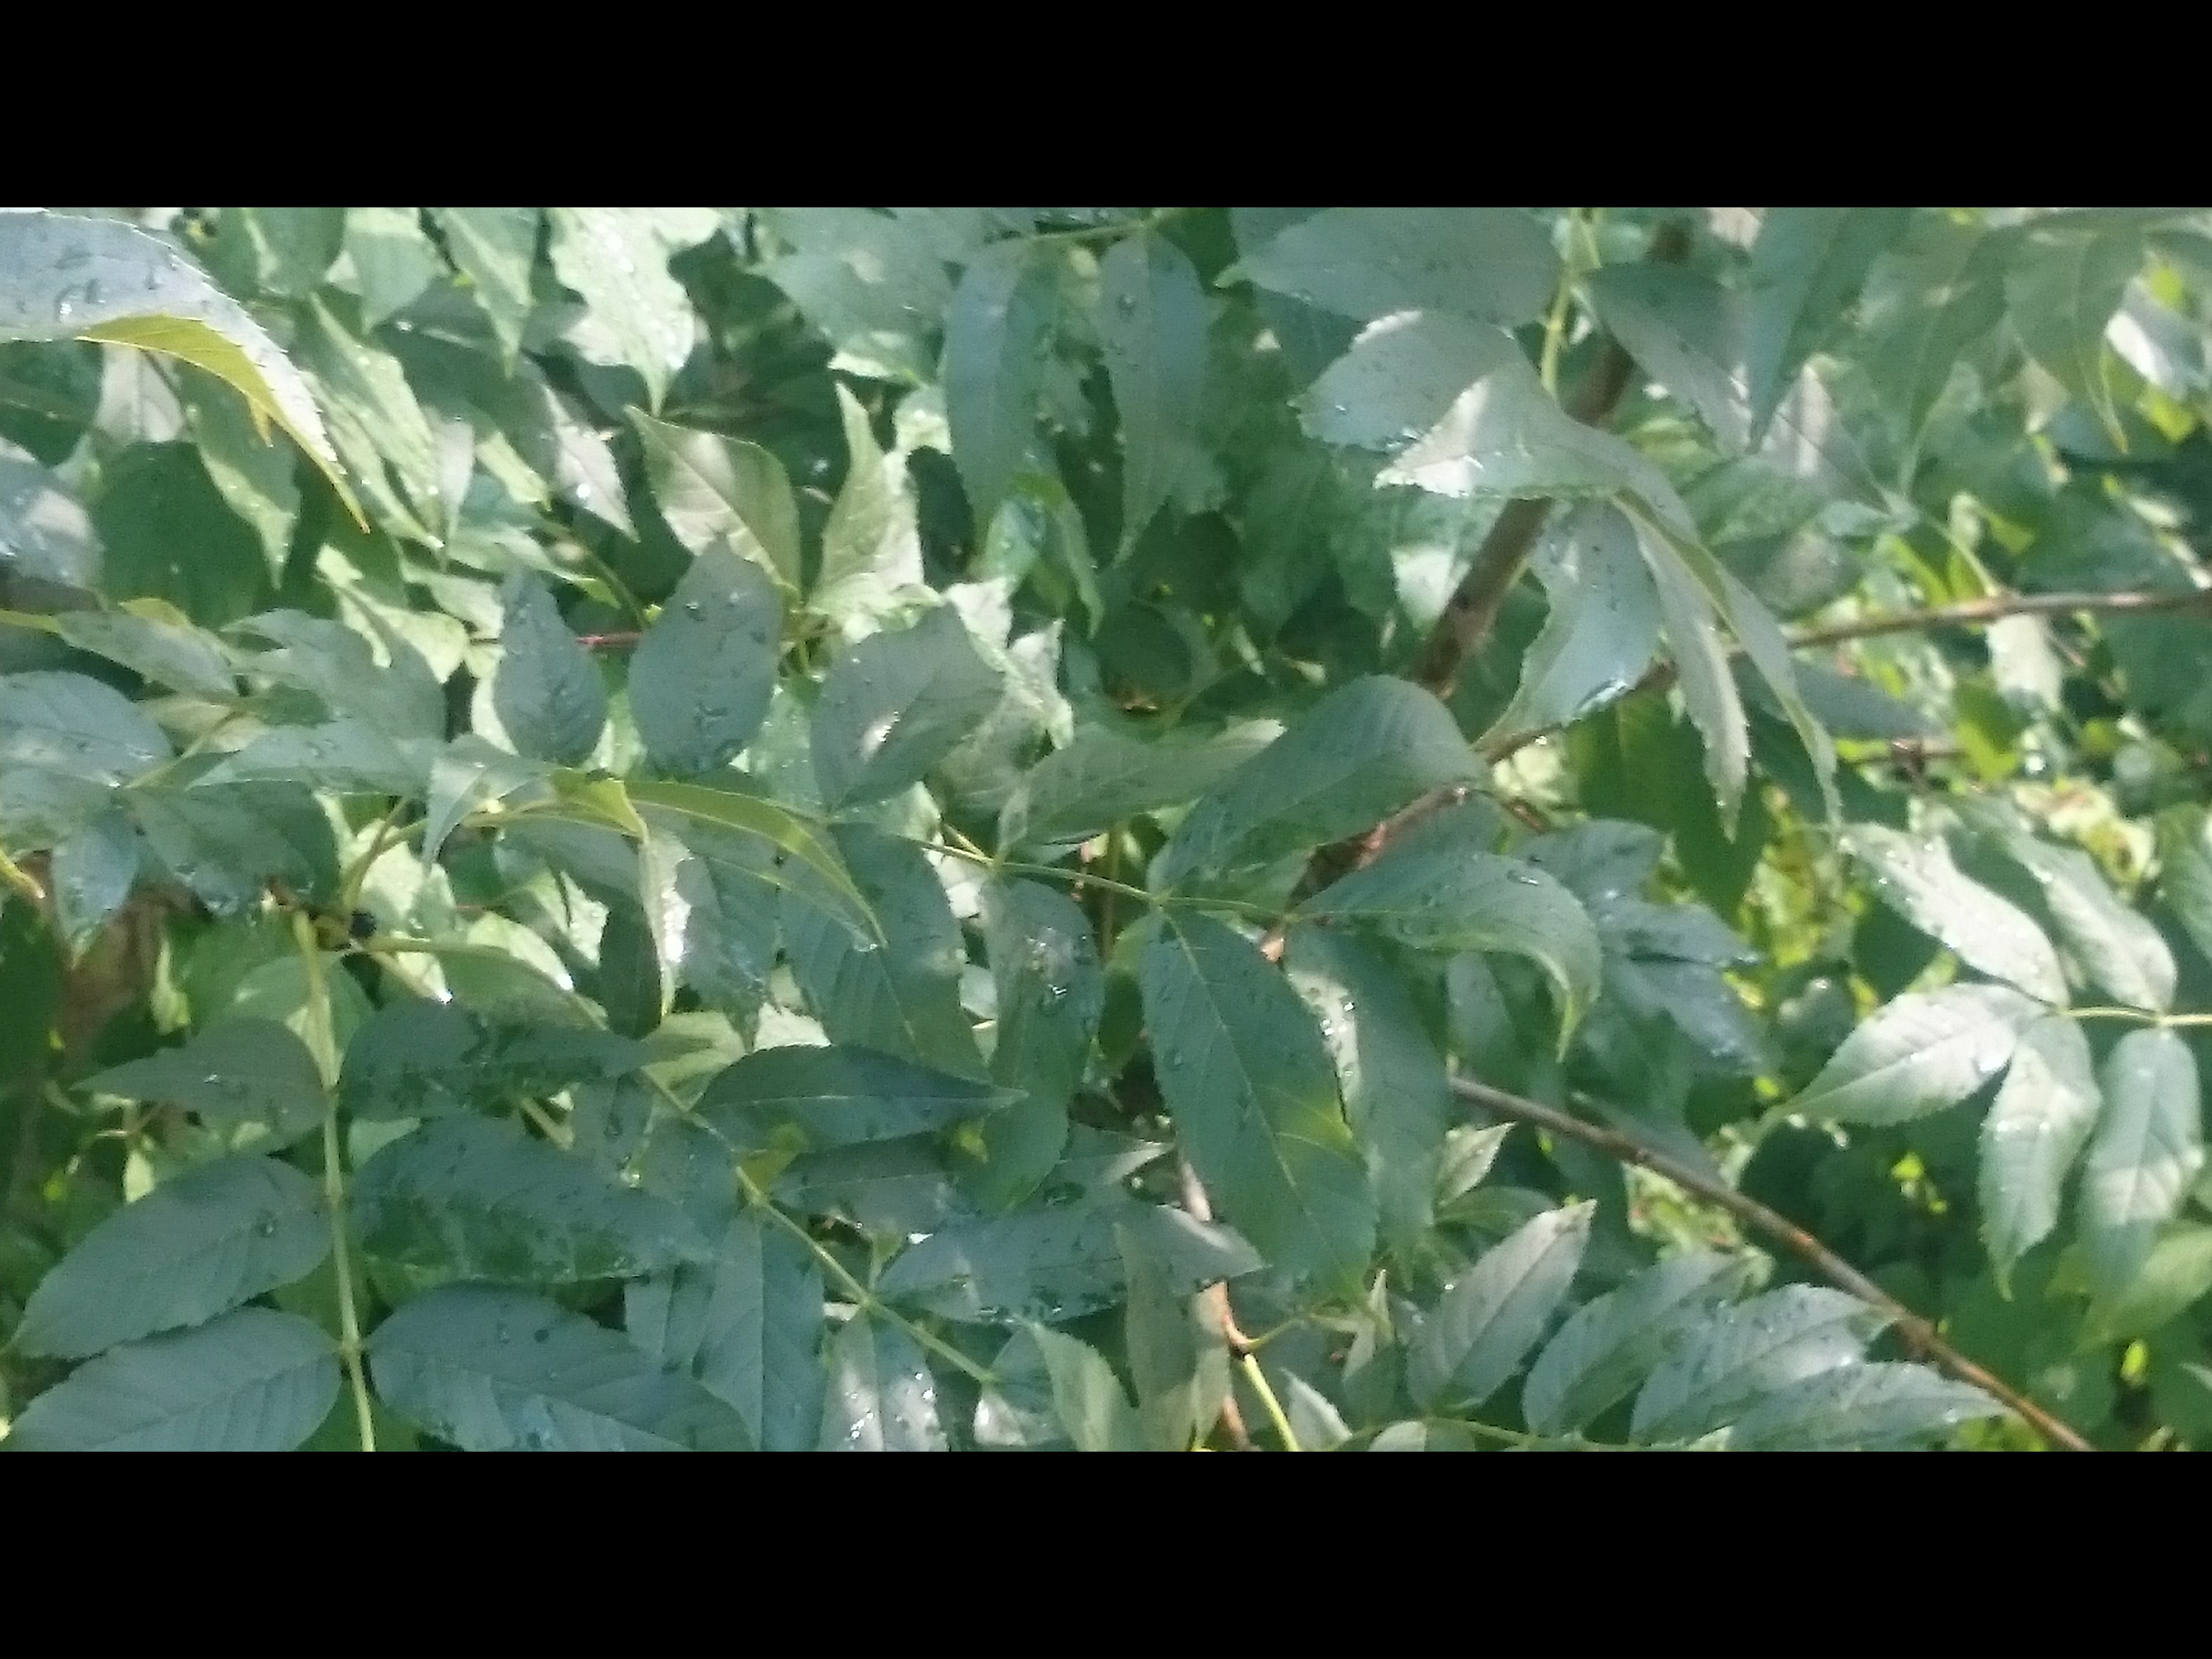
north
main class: Cropland
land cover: Maize
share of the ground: > 75 %
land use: Agriculture (excluding fallow land and kitchen gardens)
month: July
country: AT
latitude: 47.1760
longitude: 15.6610
